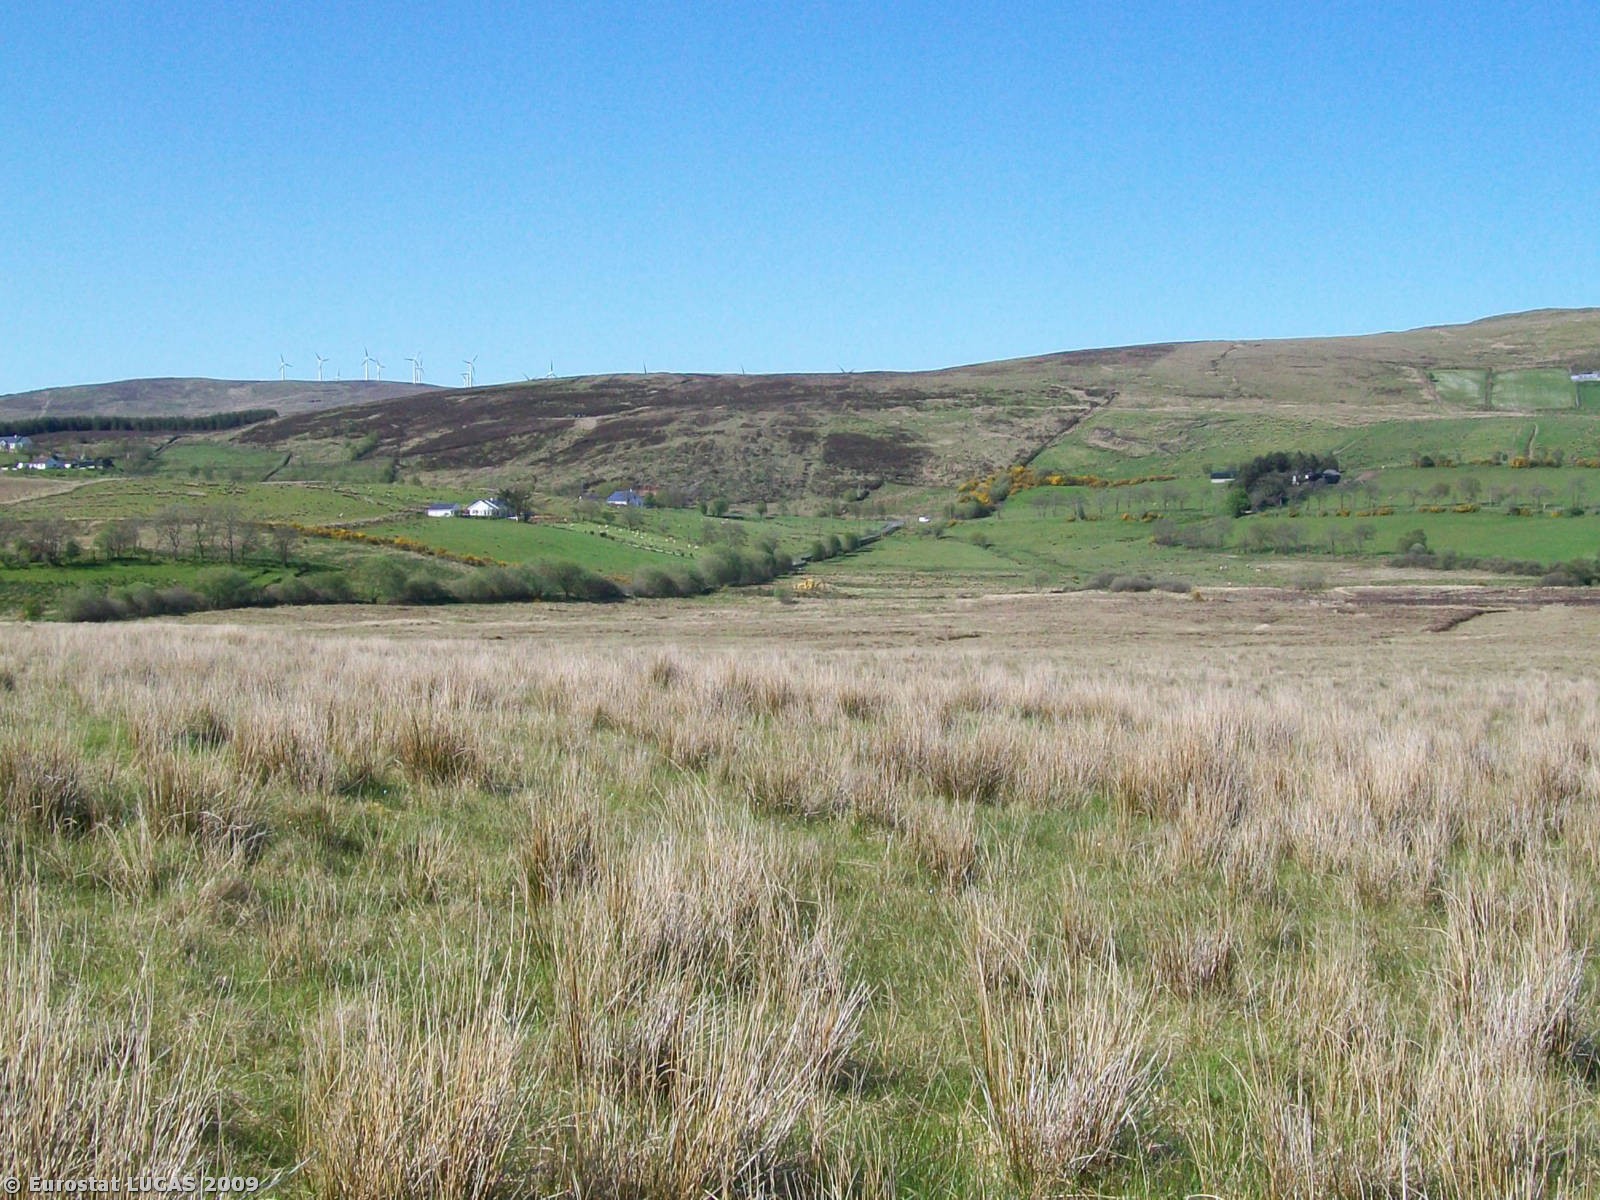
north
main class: Grassland
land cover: Grassland without tree/shrub cover
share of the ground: > 75 %
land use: Agriculture (excluding fallow land and kitchen gardens)
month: May
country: GB
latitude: 54.7736
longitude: -7.3269
